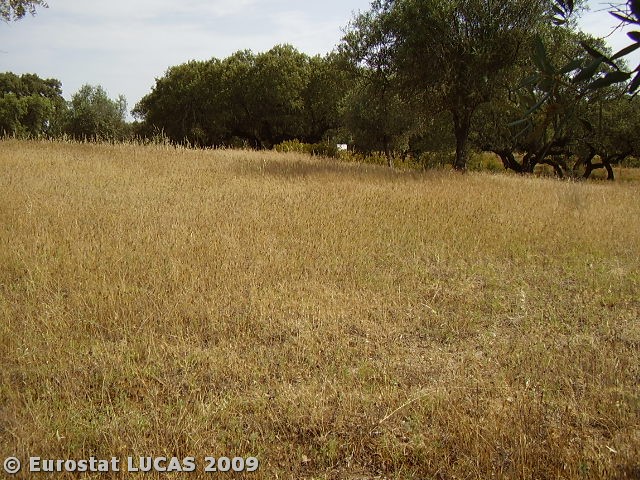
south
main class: Cropland
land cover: Olive groves
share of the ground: 10 - 25 %
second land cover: Spontaneously vegetated surfaces
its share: > 75 %
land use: Agriculture (excluding fallow land and kitchen gardens)
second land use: Fallow land
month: June
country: PT
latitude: 38.8668
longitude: -8.1810
